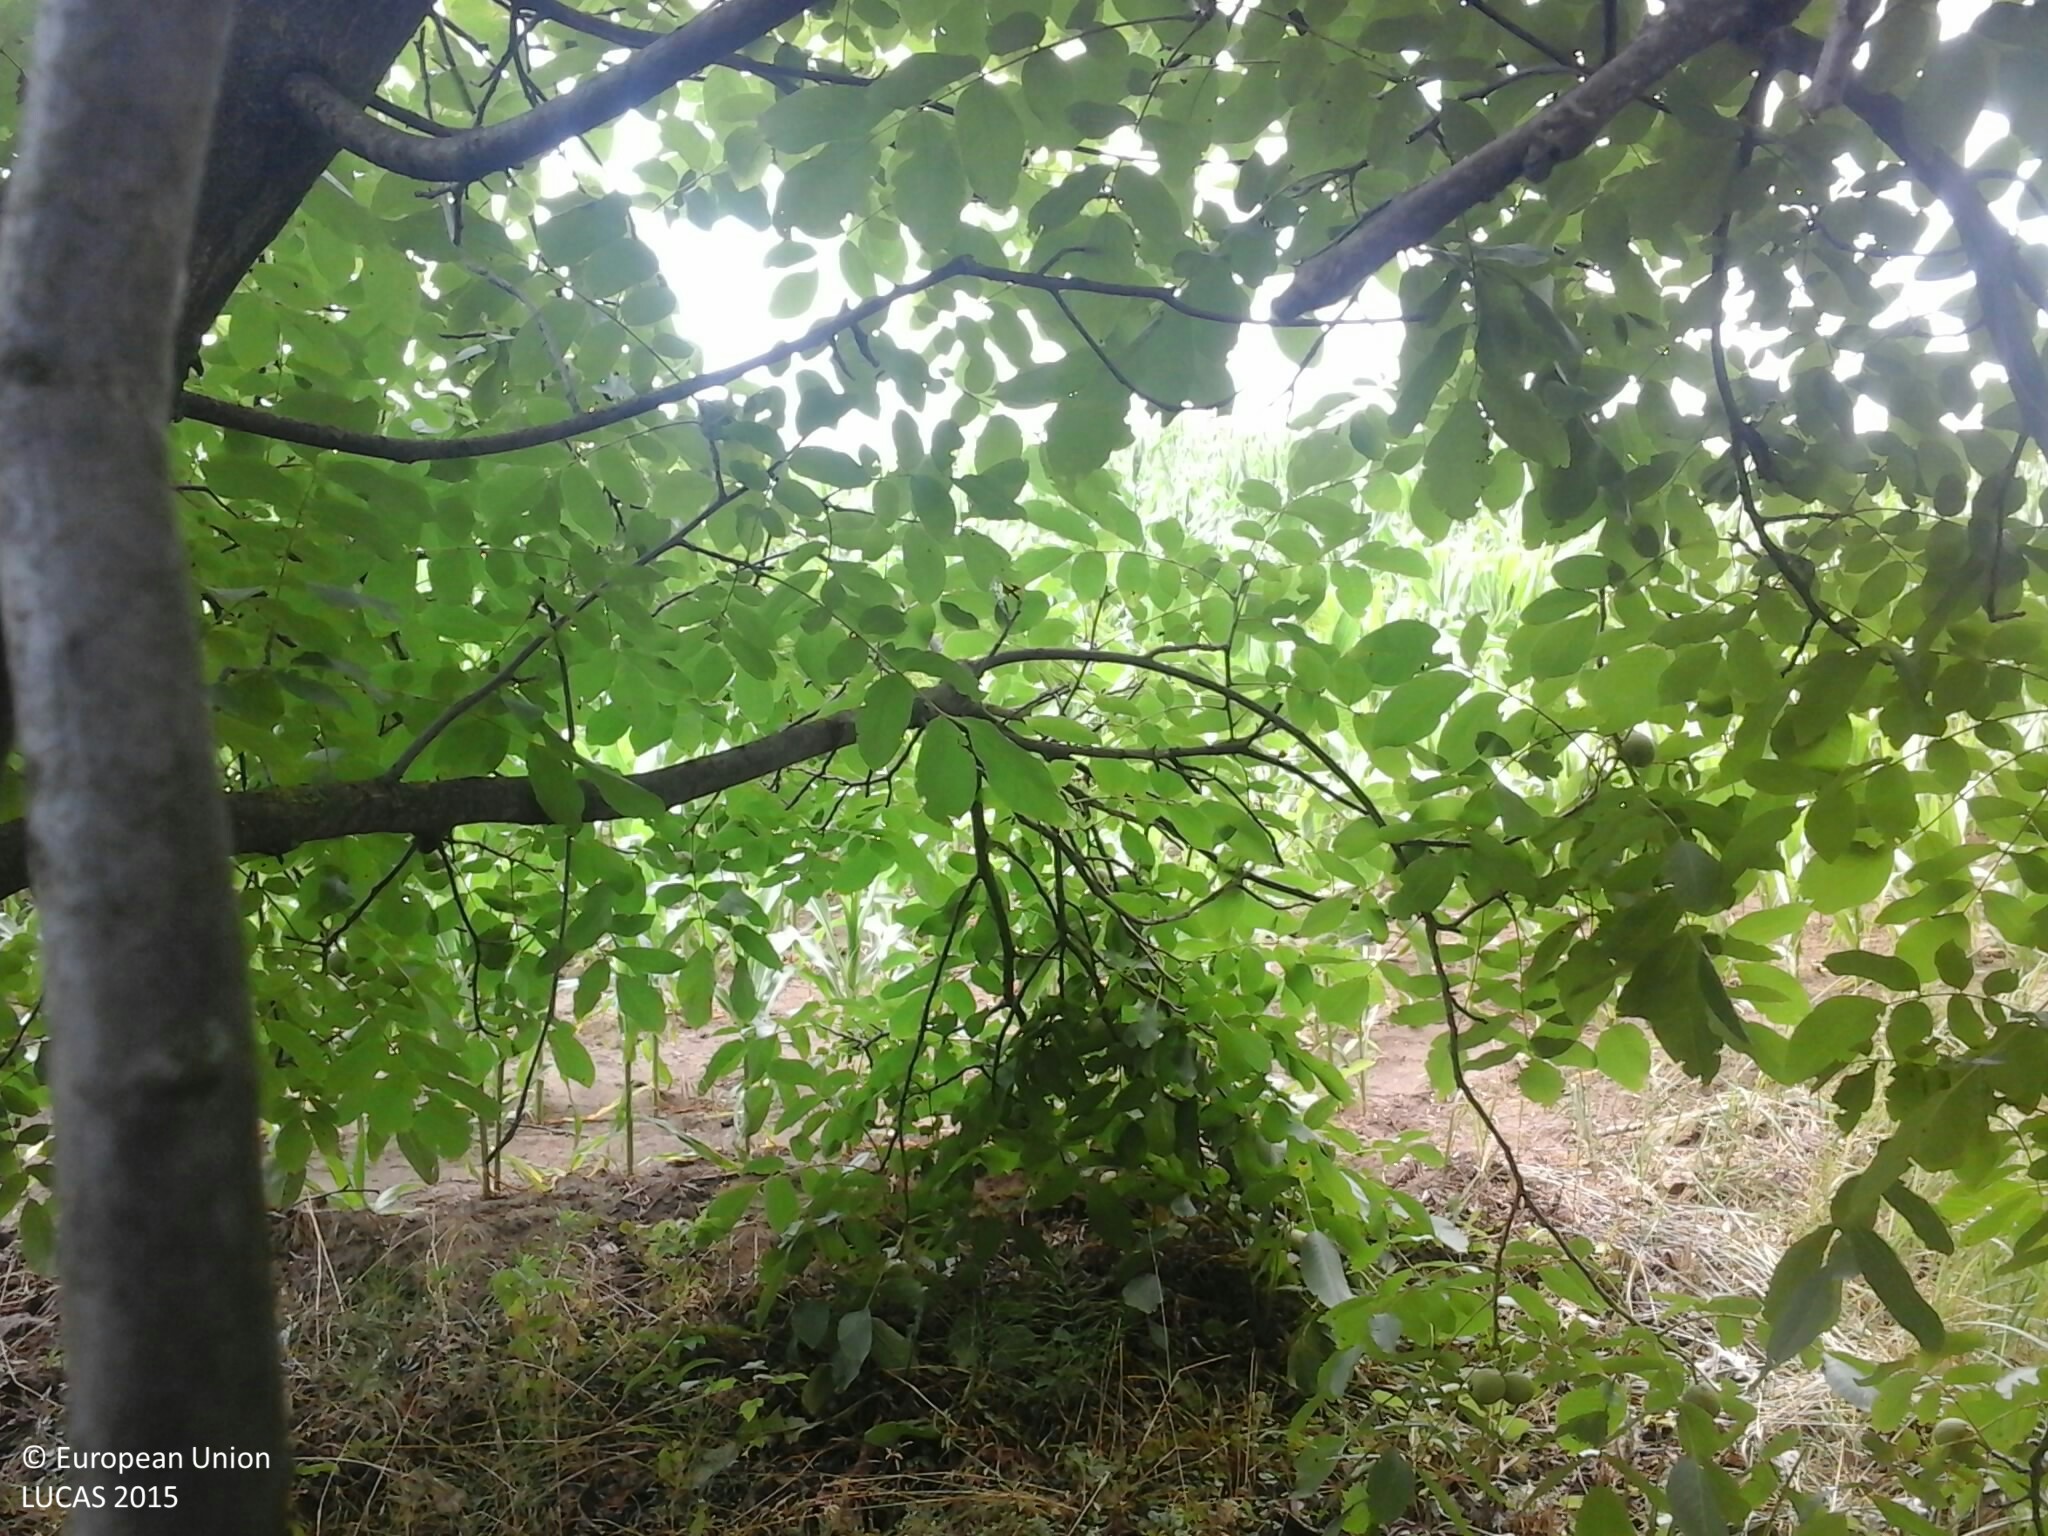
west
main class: Woodland
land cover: Broadleaved woodland
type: exotic forest
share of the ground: > 75 %
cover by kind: broadleaved forest trees 80 %, shrubs 10 %, herbaceous plants 10 %
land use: Abandoned areas
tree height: > 5 m
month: July
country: HU
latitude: 47.9022
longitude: 22.2419
